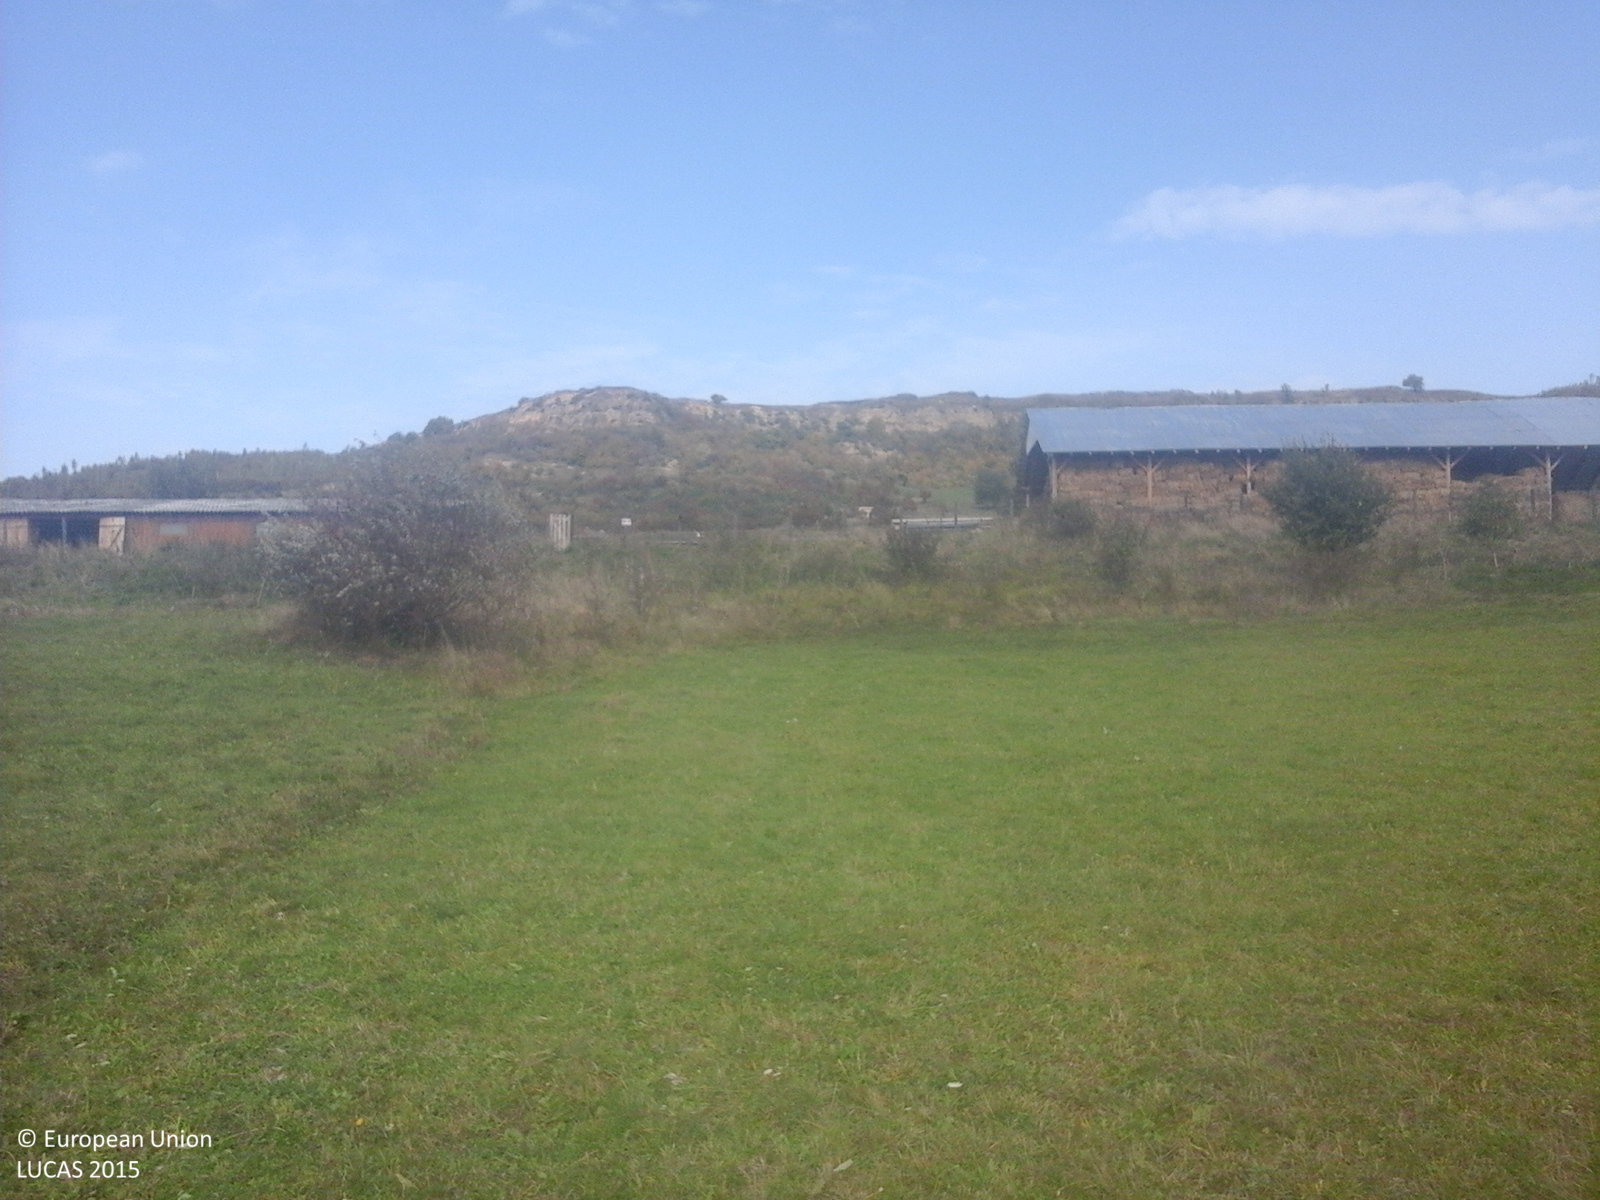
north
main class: Grassland
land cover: Grassland without tree/shrub cover
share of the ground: > 75 %
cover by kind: herbaceous plants 100 %
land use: Agriculture (excluding fallow land and kitchen gardens)
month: October
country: RO
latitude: 46.2474
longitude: 25.3169
